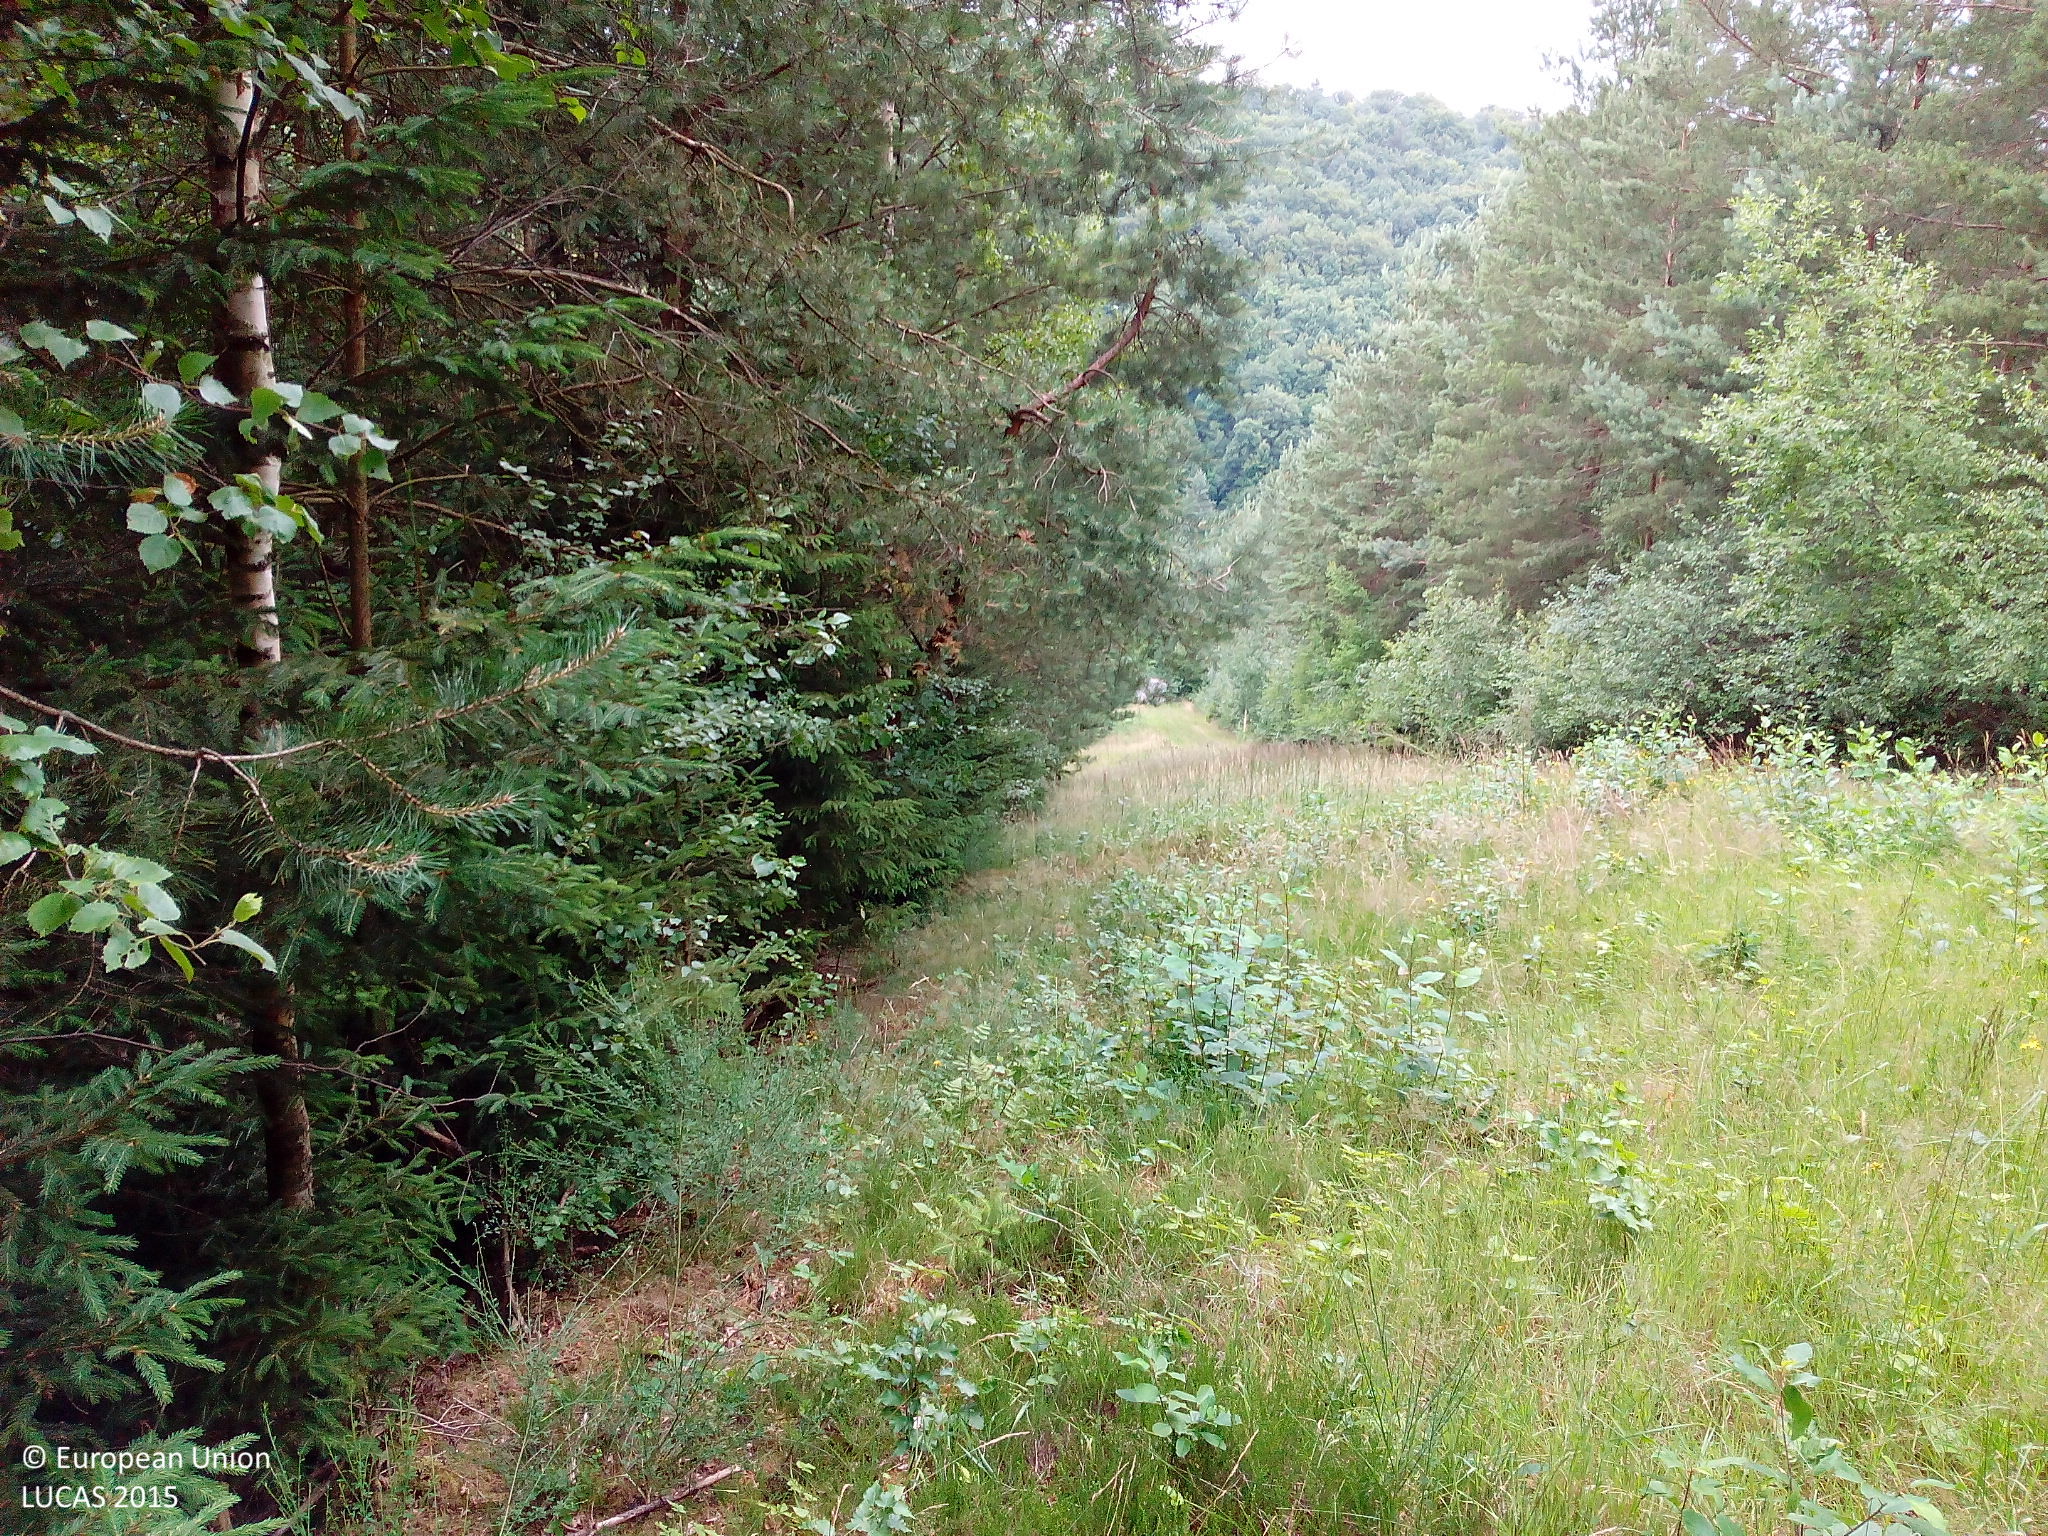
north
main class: Woodland
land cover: Spruce dominated mixed woodland
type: hemiboreal forest and nemoral coniferous forest and mixed broadleaved-coniferous forest
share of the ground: > 75 %
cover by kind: coniferous forest trees 60 %, broadleaved forest trees 40 %
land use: Forestry
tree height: > 5 m
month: July
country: DE
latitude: 50.8135
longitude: 9.9574
